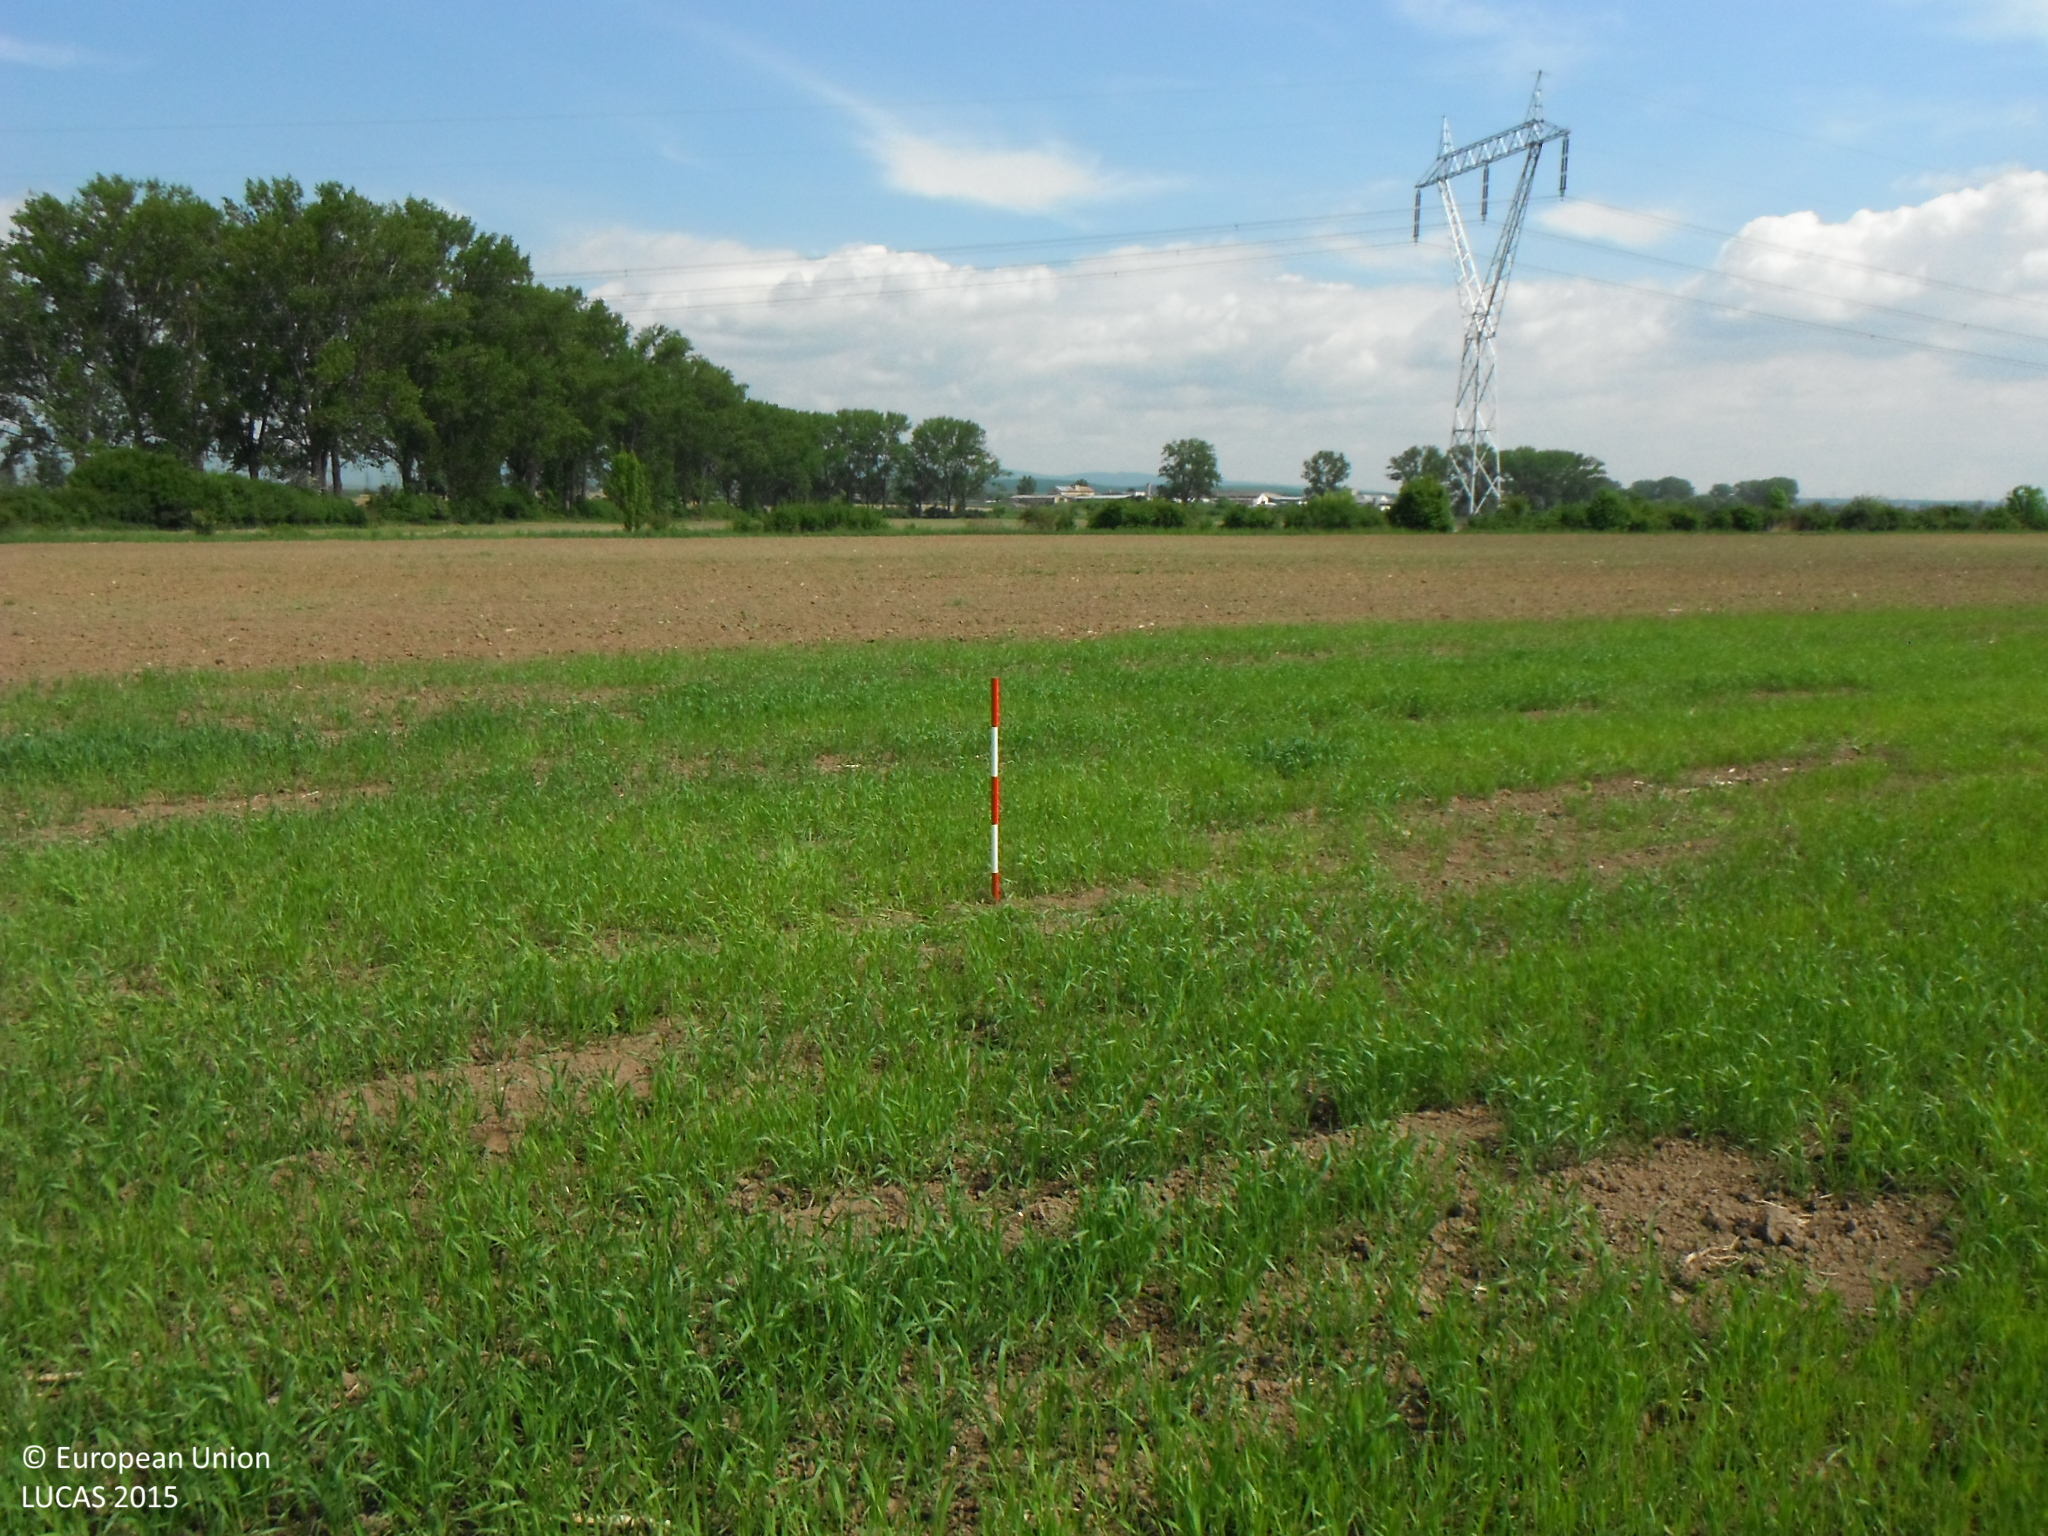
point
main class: Cropland
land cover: Common wheat
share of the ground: > 75 %
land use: Agriculture (excluding fallow land and kitchen gardens)
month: May
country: SK
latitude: 48.5785
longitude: 21.0067
